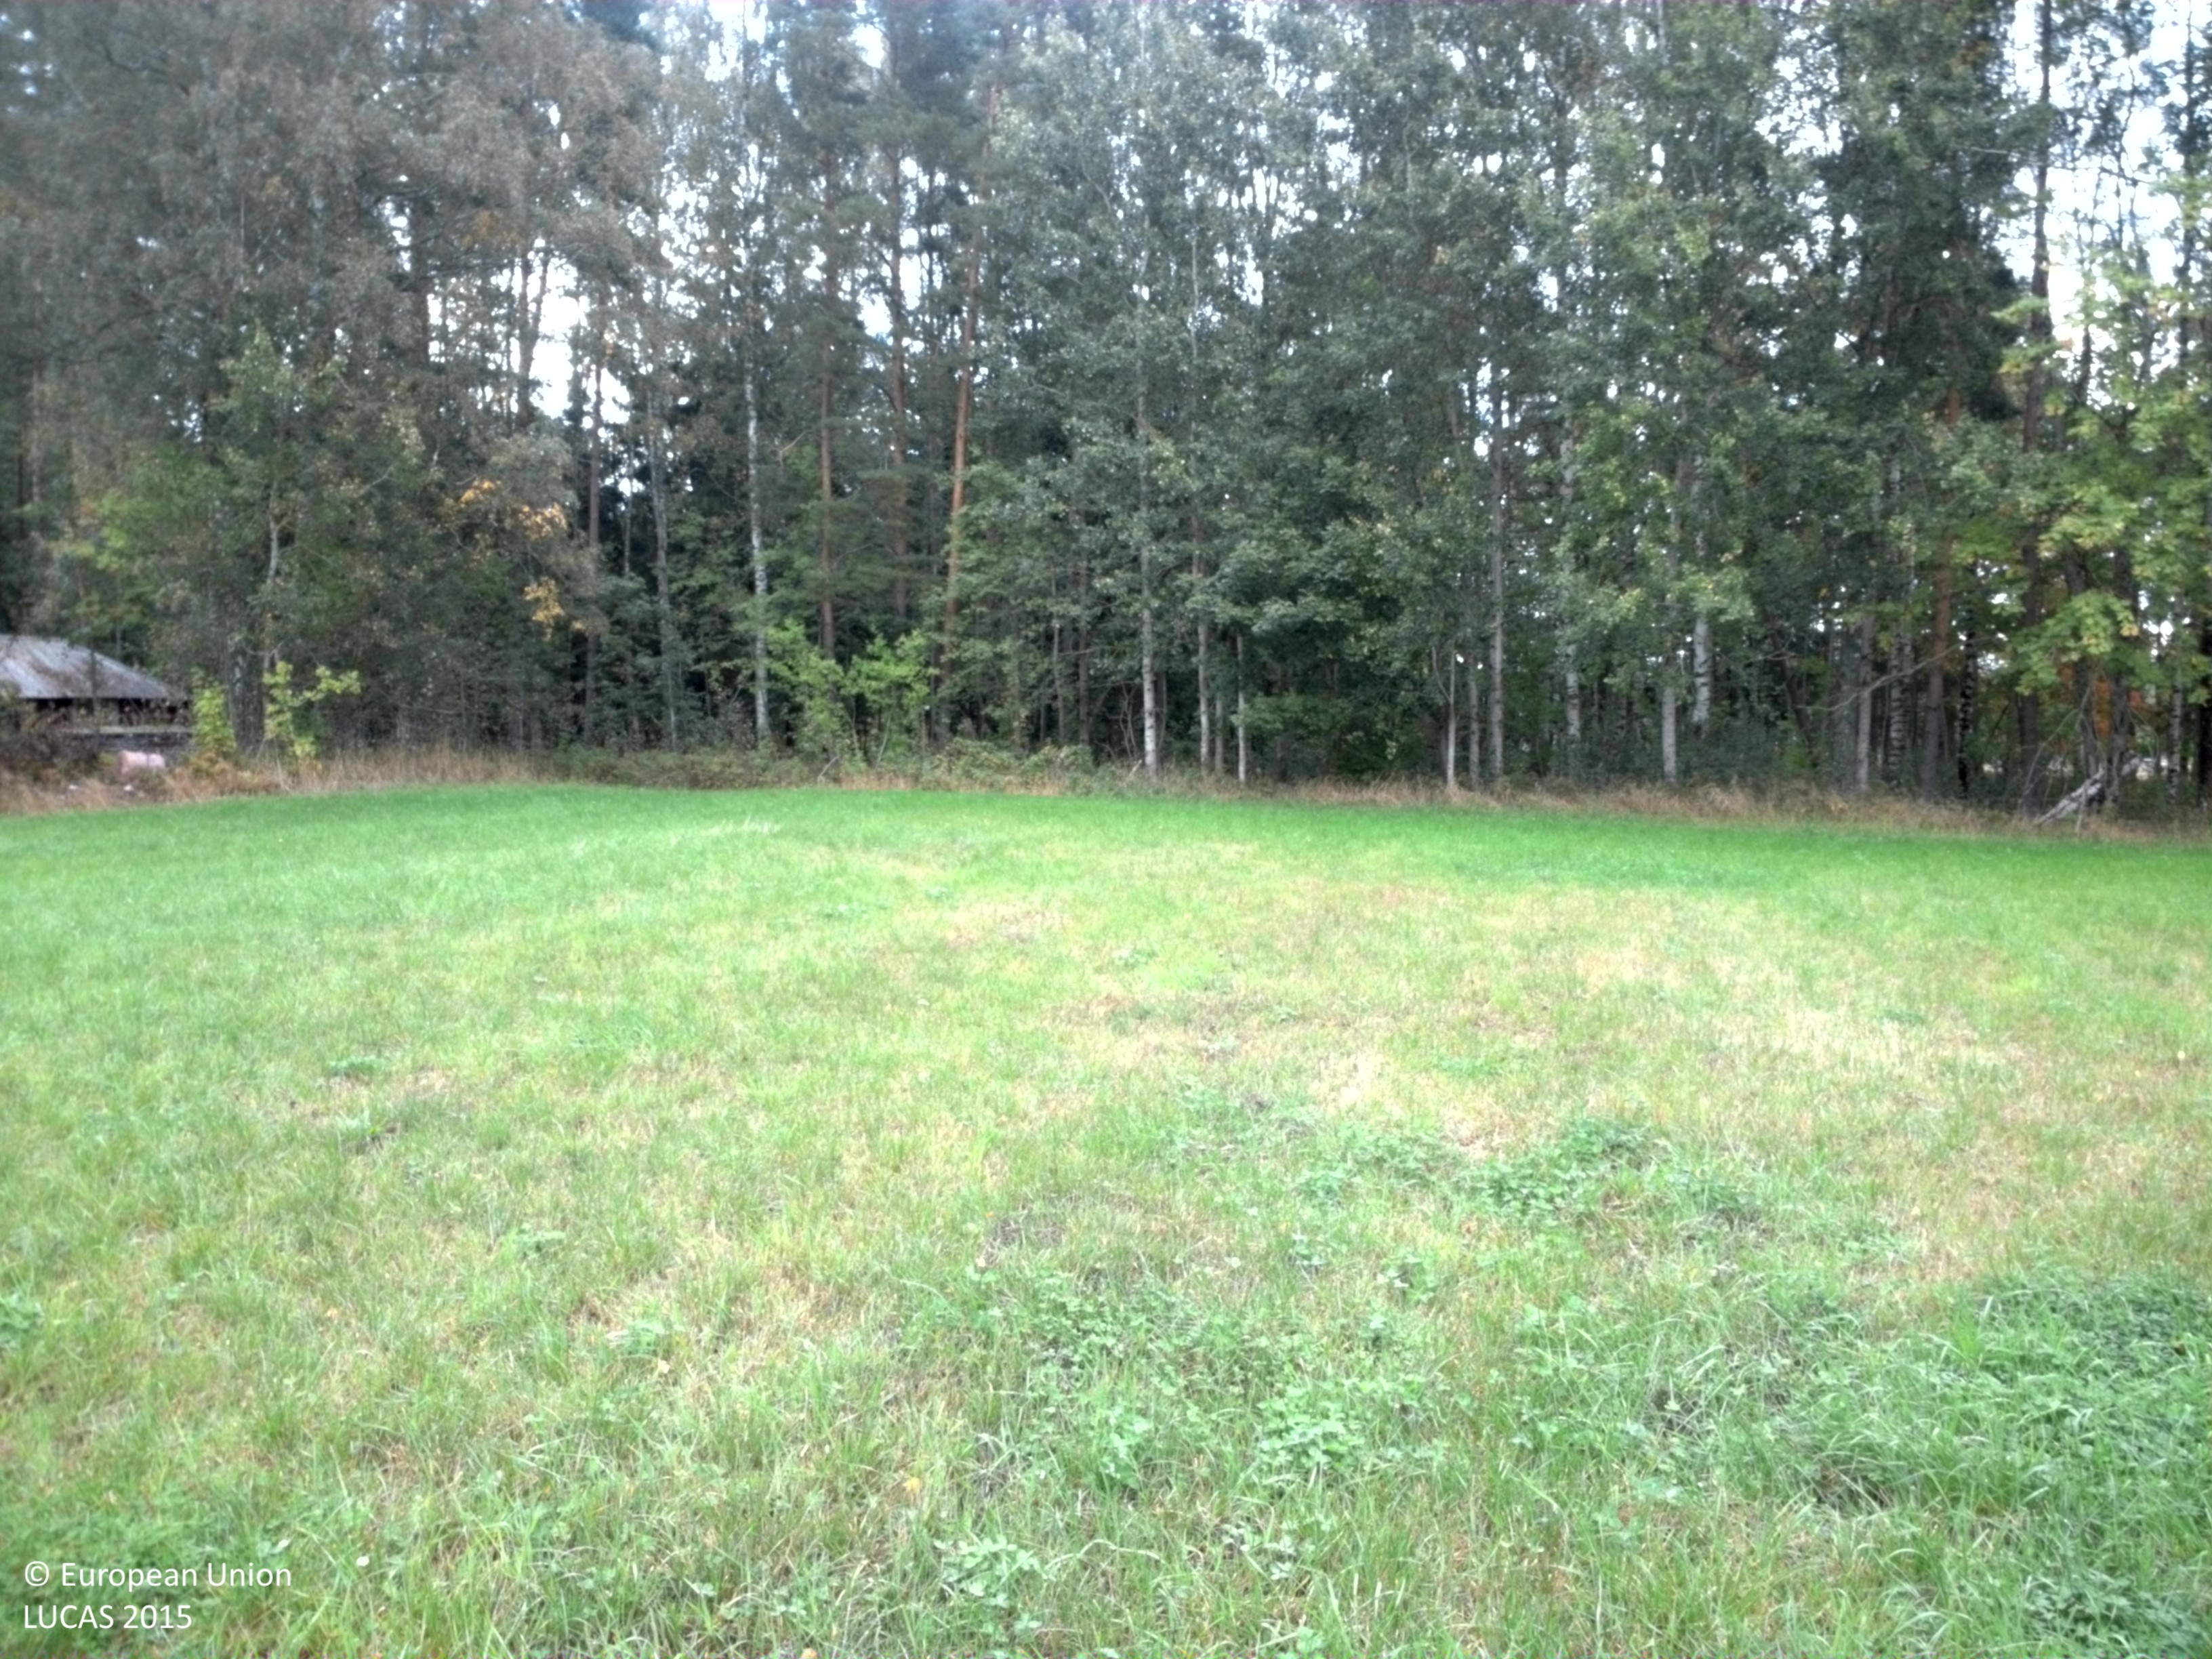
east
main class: Cropland
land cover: Temporary grasslands
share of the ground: > 75 %
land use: Agriculture (excluding fallow land and kitchen gardens)
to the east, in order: Temporary grasslands; Pine dominated mixed woodland; Fences; Other mixed woodland; Ditches and canals; Spruce dominated mixed woodland; Fences; Spruce dominated mixed woodland; Fences; Broadleaved woodland; Artificial constructions in urban areas; Pine dominated mixed woodland; Paved roads, cycling and walking lanes; Pine dominated mixed woodland; Broadleaved woodland
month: September
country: SE
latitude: 59.0042
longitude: 14.0837
